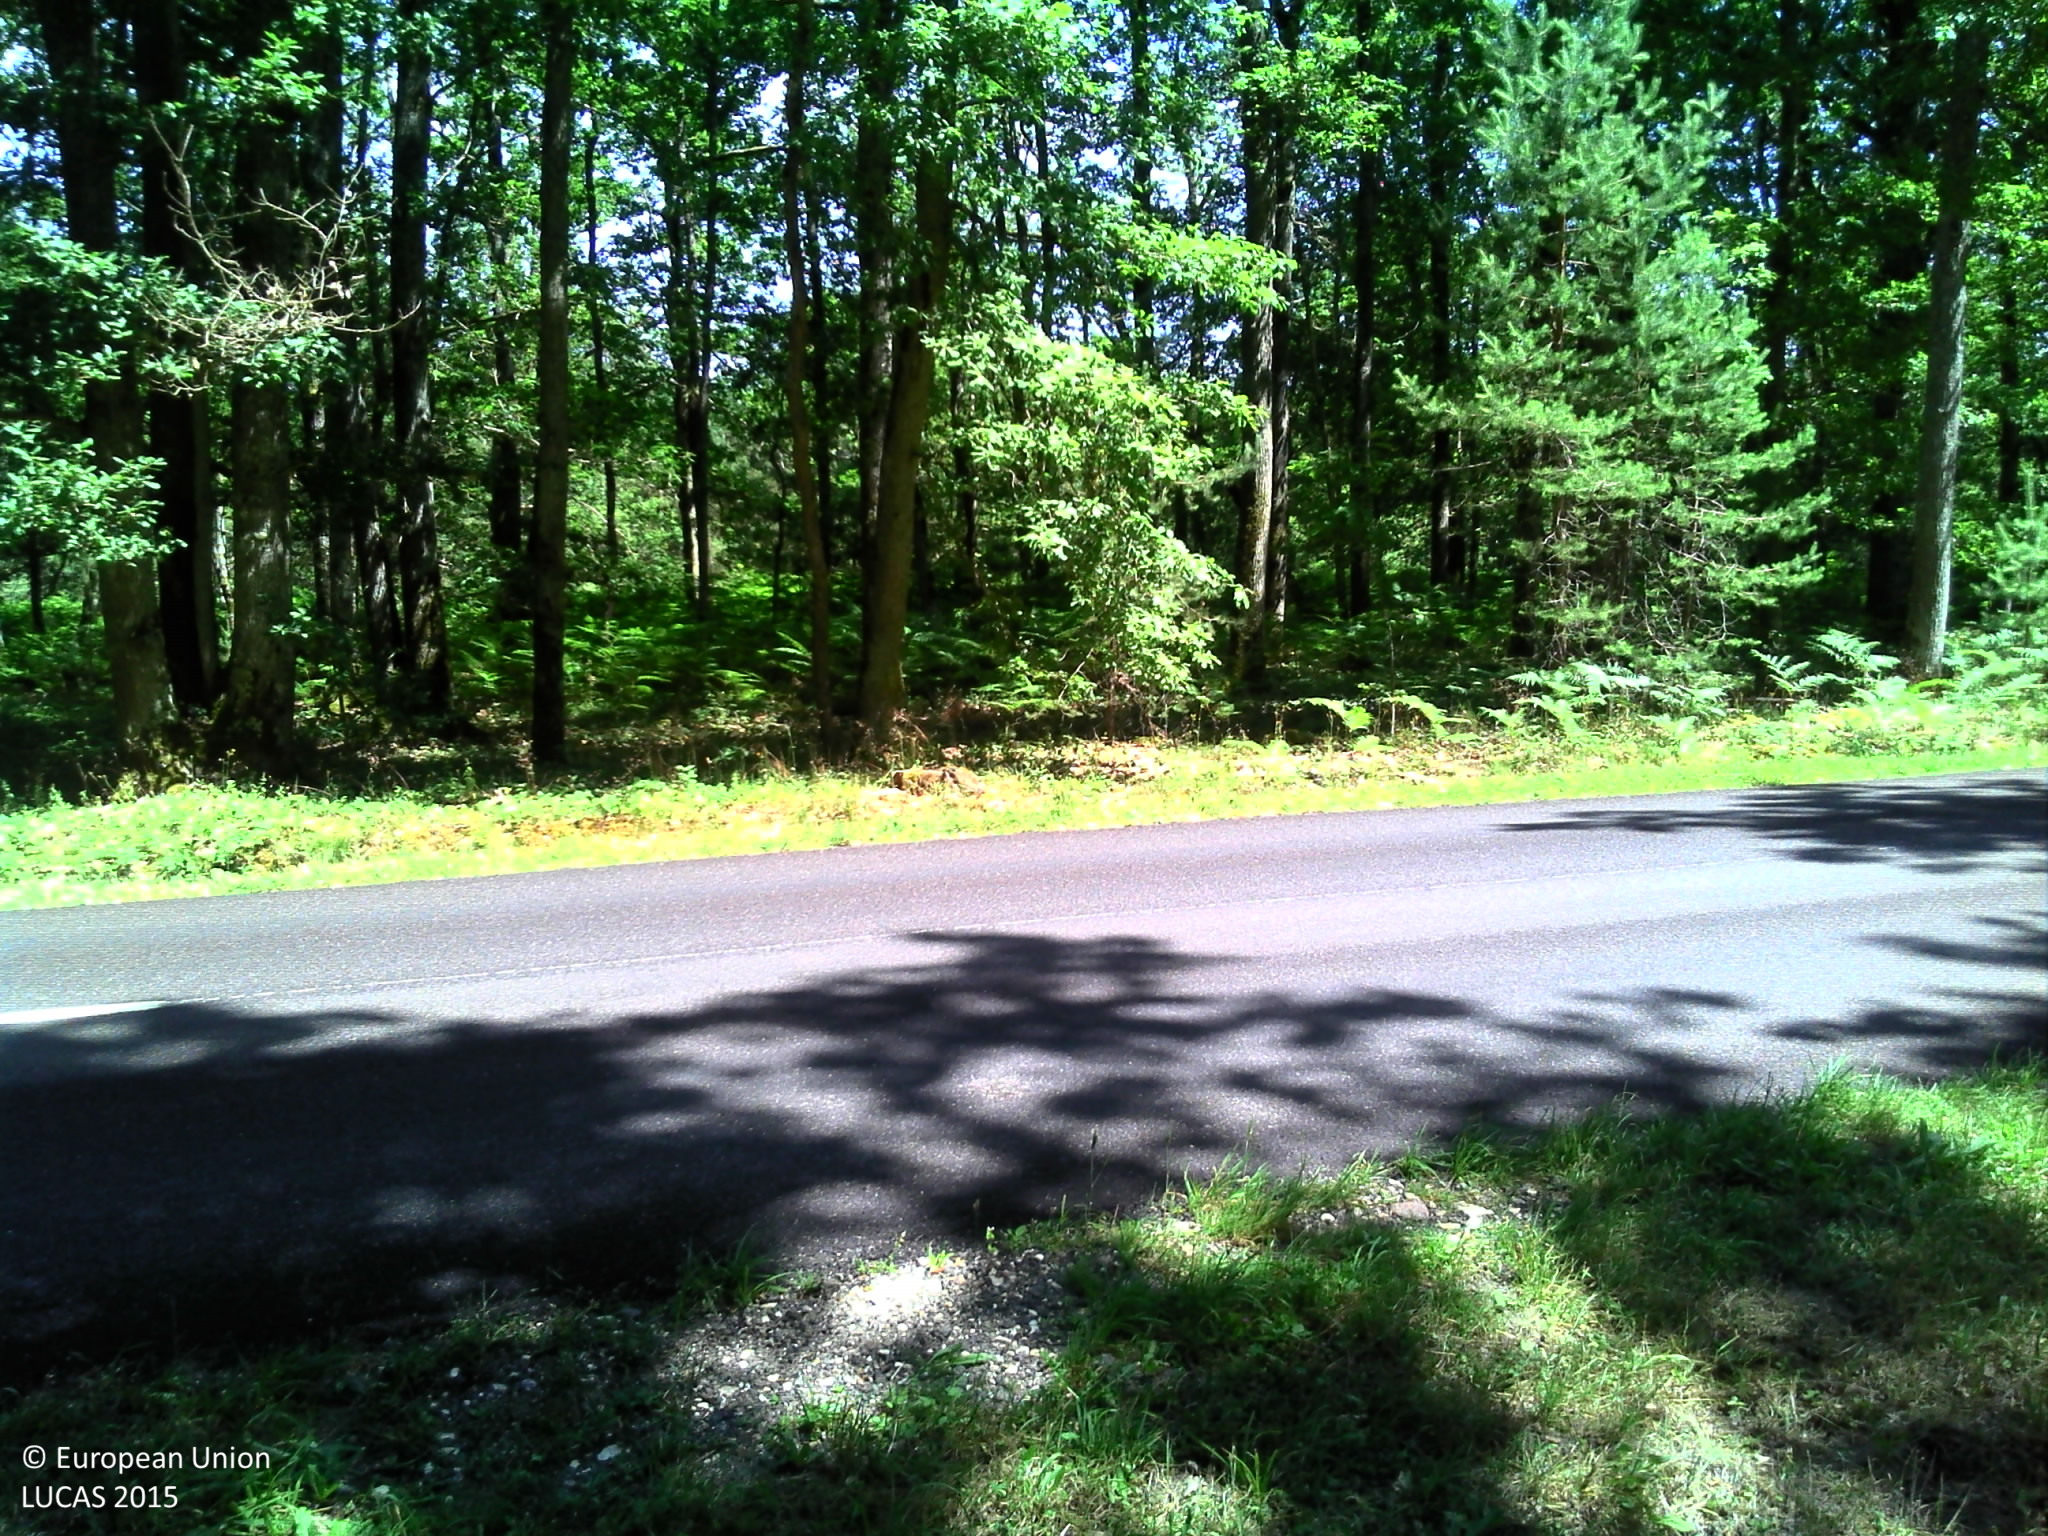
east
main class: Woodland
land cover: Pine dominated mixed woodland
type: acidophilous oak and oak-birch forest
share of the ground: > 75 %
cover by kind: coniferous forest trees 75 %, broadleaved forest trees 25 %
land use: Forestry
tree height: > 5 m
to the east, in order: Pine dominated mixed woodland; Fences; Grass margins; Ditches and canals; Grass margins; Paved roads, cycling and walking lanes; Grass margins; Ditches and canals; Grass margins; Pine dominated mixed woodland
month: June
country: FR
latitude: 47.7588
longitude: 2.6144
